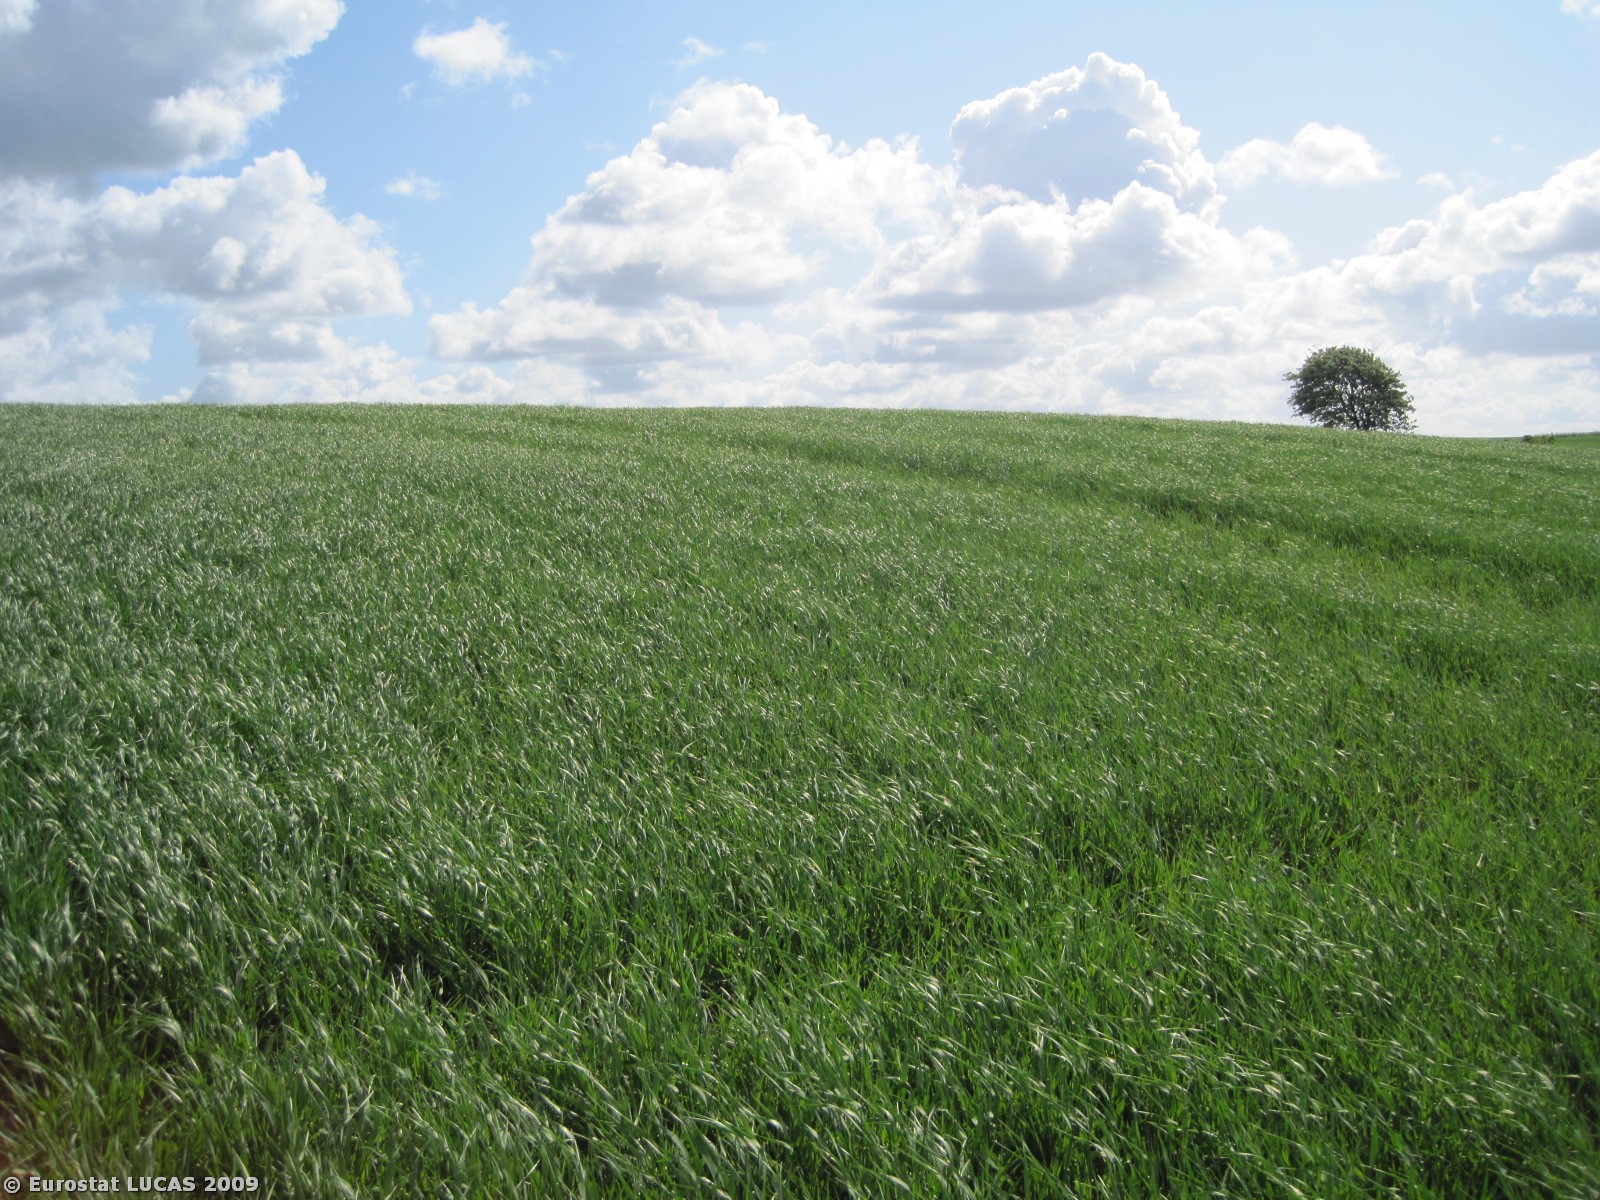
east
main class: Cropland
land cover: Barley
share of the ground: > 75 %
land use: Agriculture (excluding fallow land and kitchen gardens)
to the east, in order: Barley; Grass margins; Tracks; Barley
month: May
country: DK
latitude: 56.5649
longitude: 9.6912
